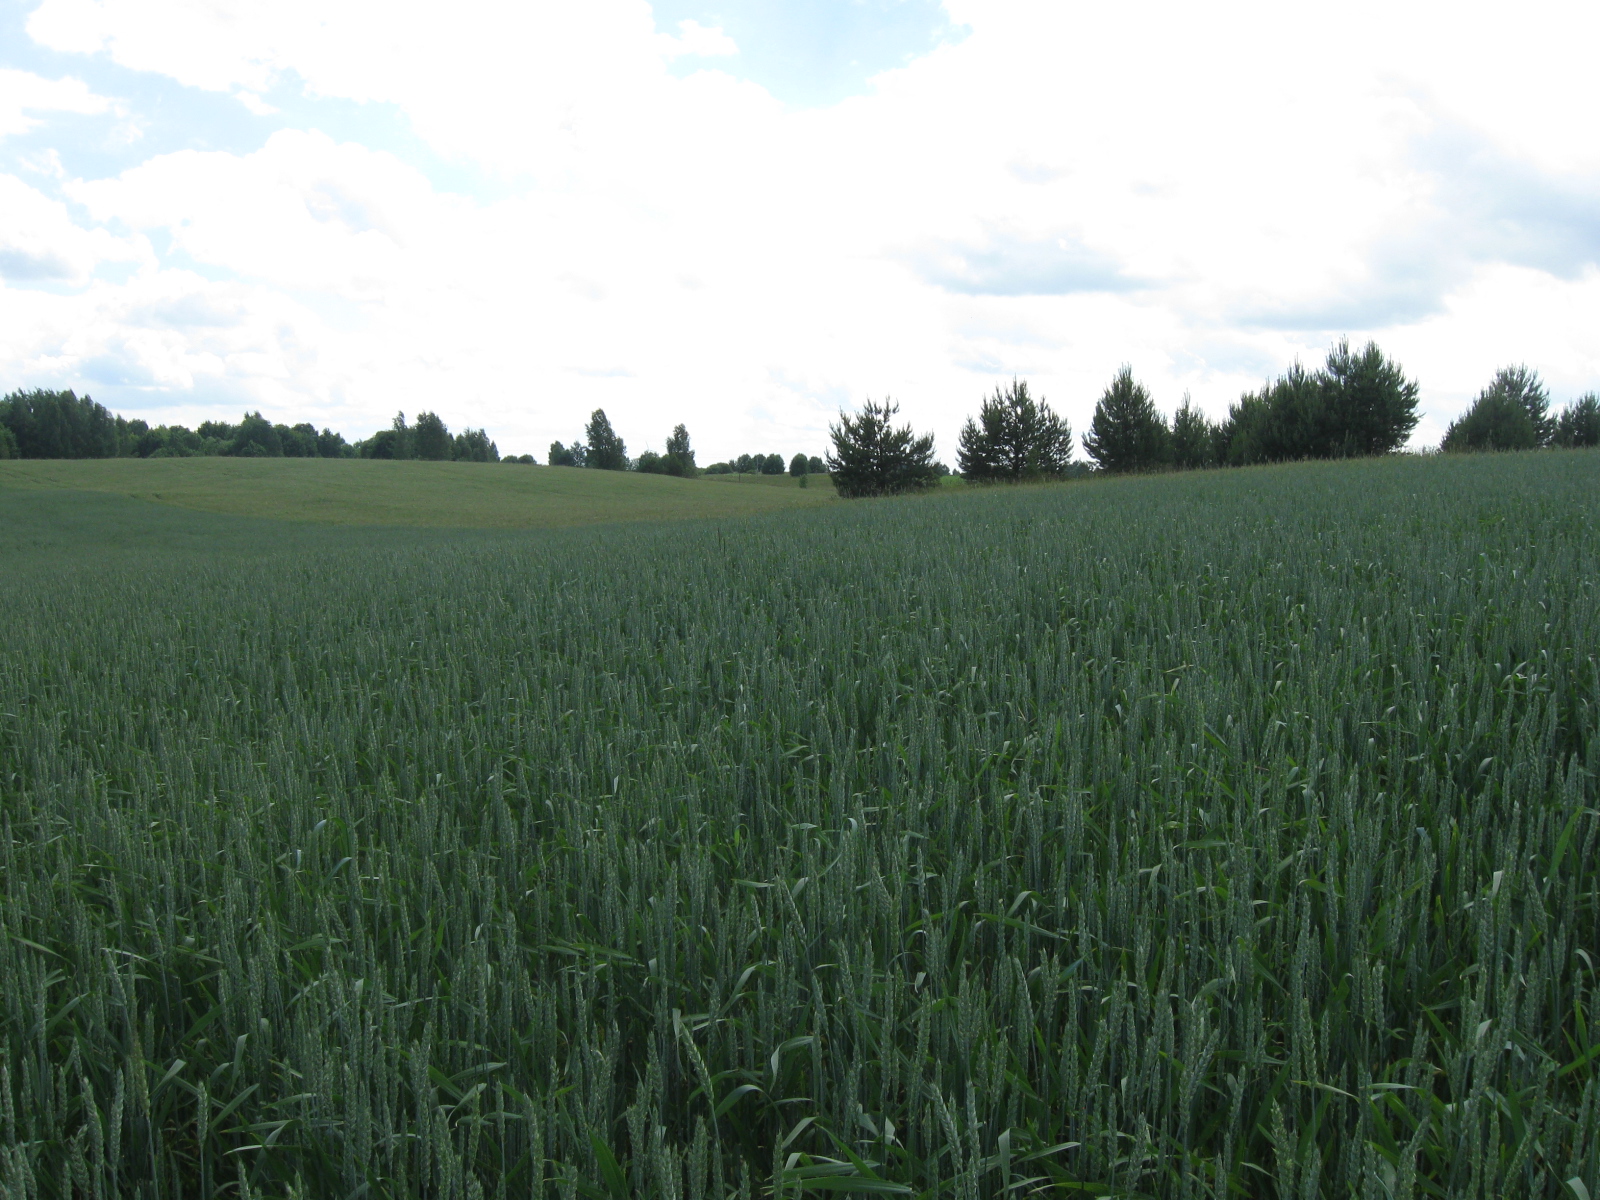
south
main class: Cropland
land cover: Common wheat
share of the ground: > 75 %
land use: Agriculture (excluding fallow land and kitchen gardens)
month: June
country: LT
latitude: 54.6516
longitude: 24.4377
